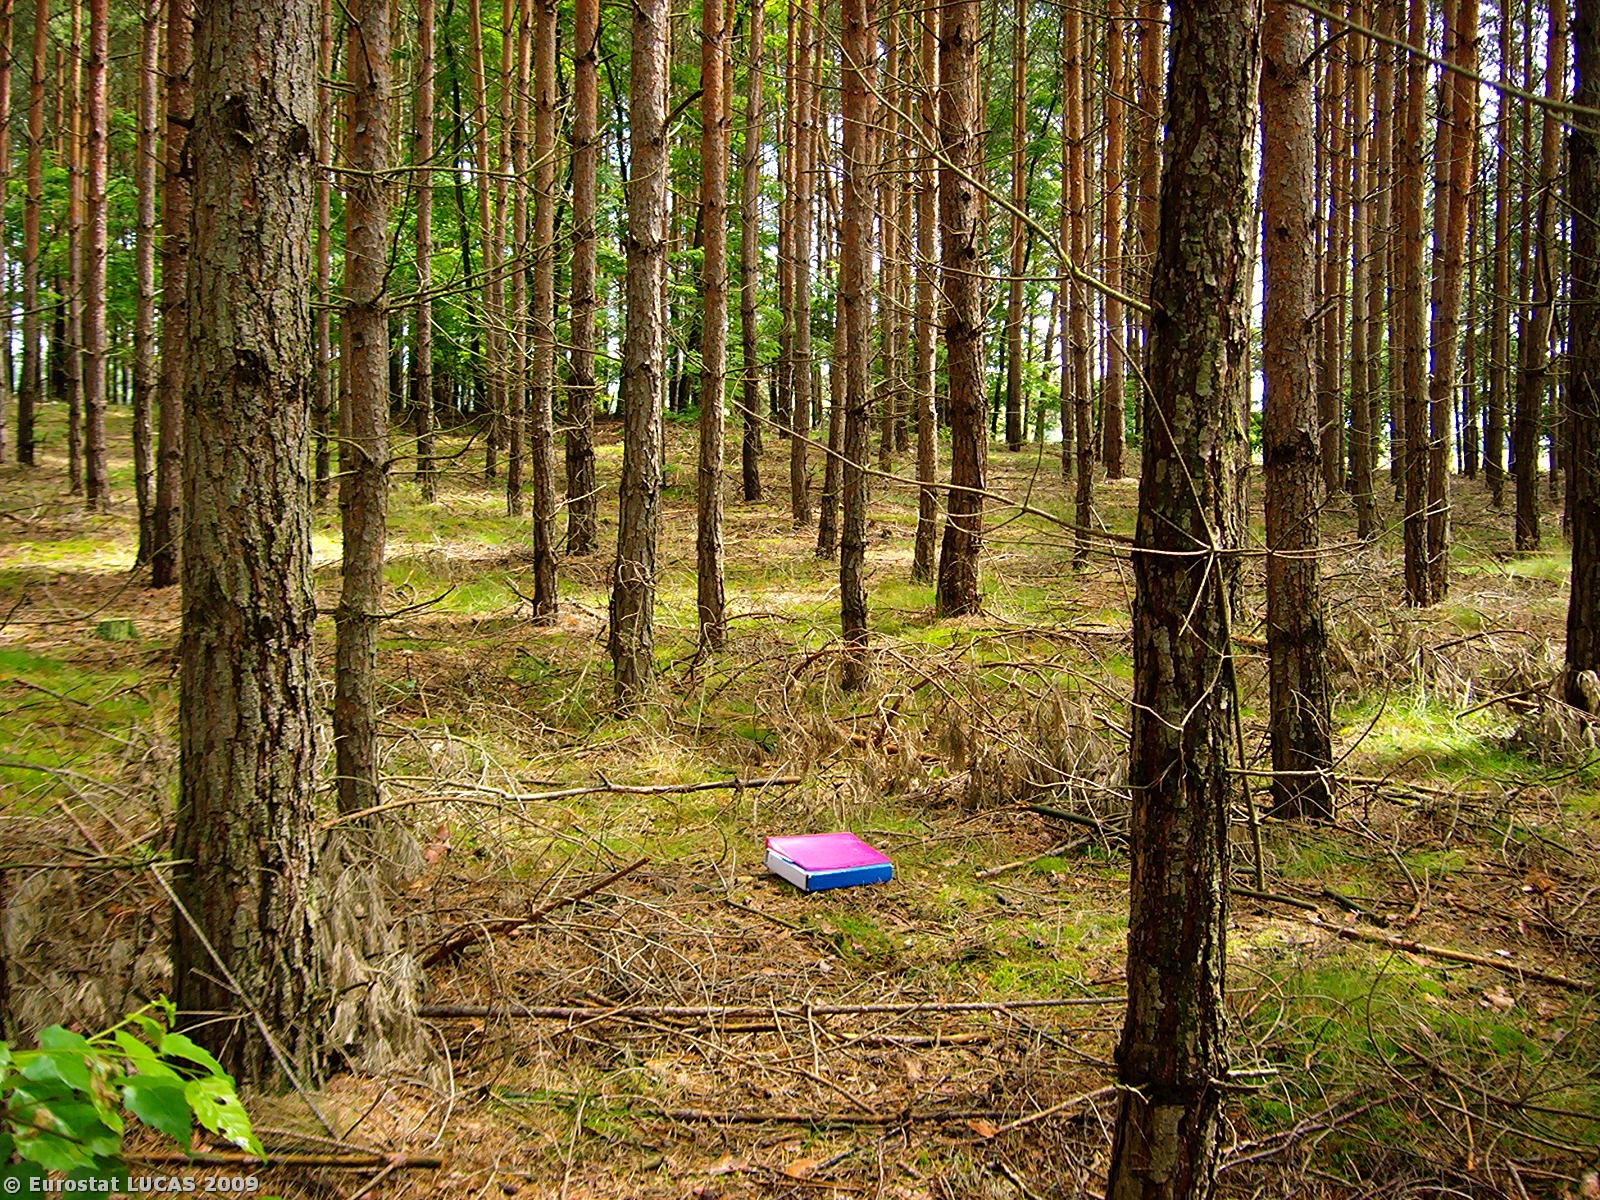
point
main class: Woodland
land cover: Coniferous woodland
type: hemiboreal forest and nemoral coniferous forest and mixed broadleaved-coniferous forest
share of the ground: > 75 %
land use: Forestry
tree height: > 5 m
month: July
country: PL
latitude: 52.2927
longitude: 15.3552
